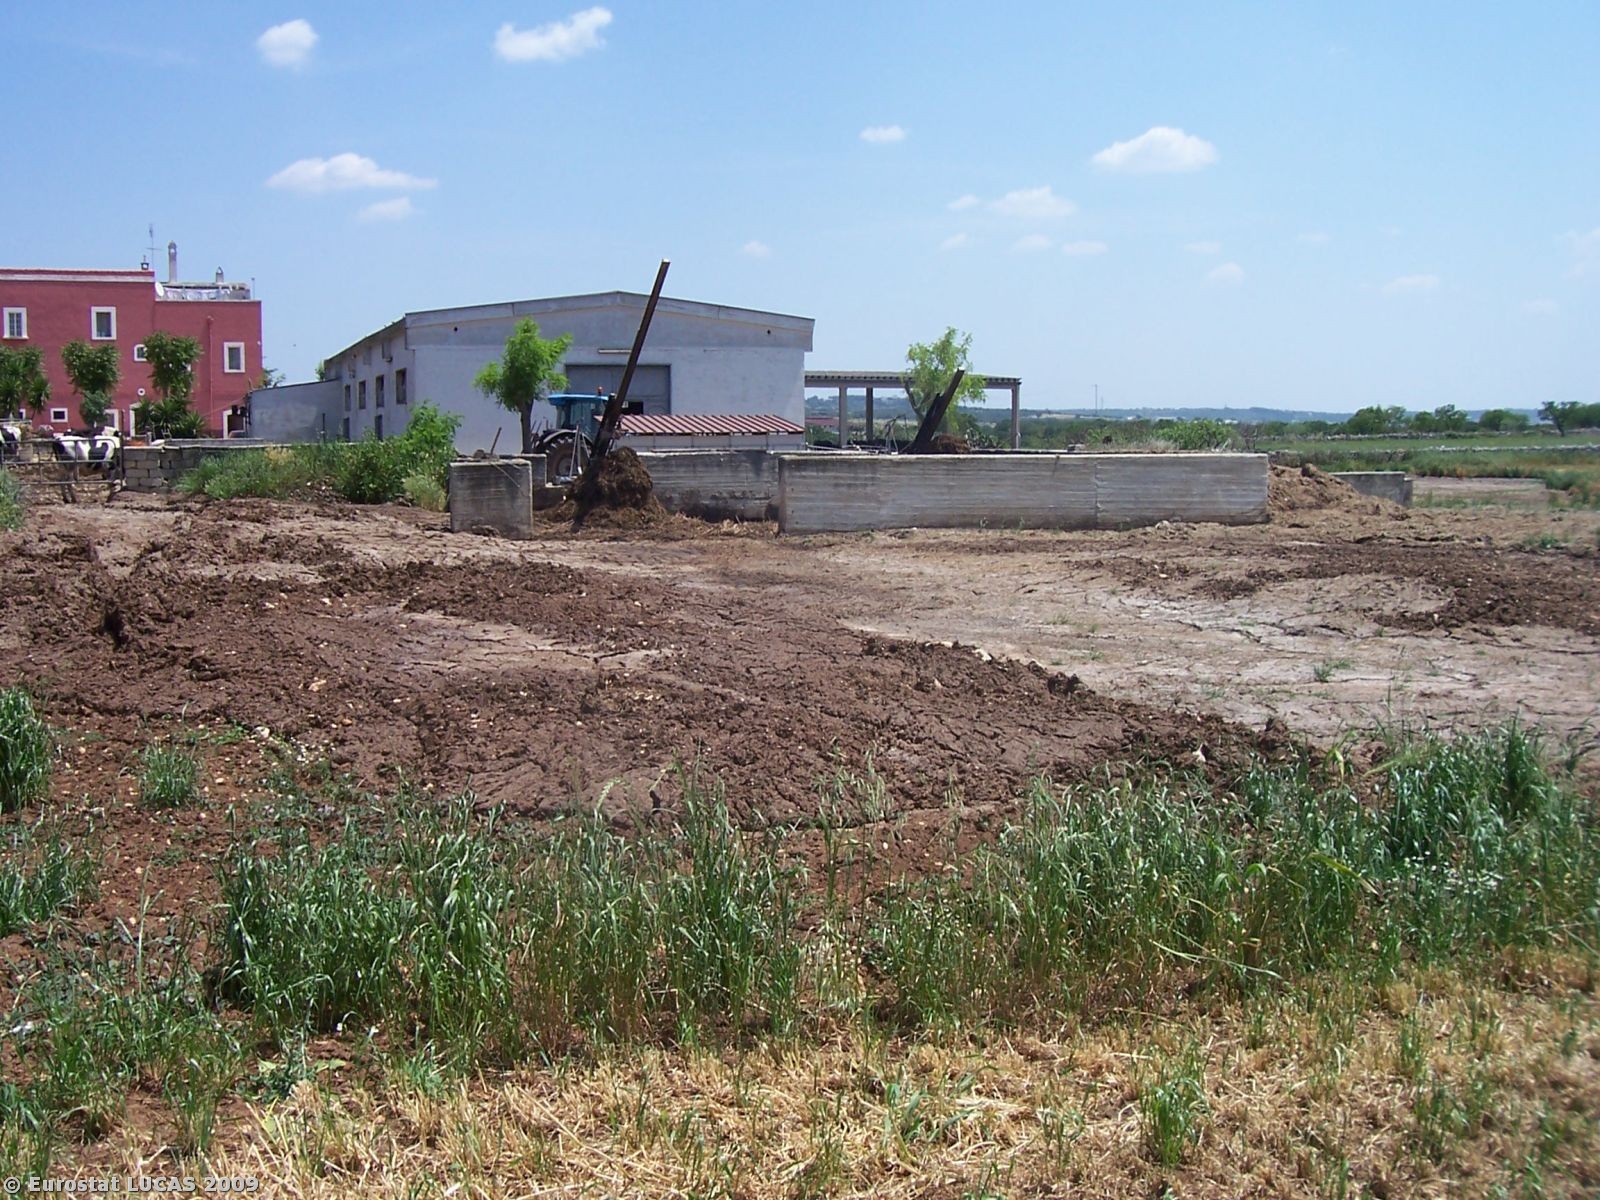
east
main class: Cropland
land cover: Other leguminous and mixtures for fodder
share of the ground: < 10 %
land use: Agriculture (excluding fallow land and kitchen gardens)
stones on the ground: < 10 %
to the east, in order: Other leguminous and mixtures for fodder; Artificial constructions in urban areas; Bare land; Fences; Other leguminous and mixtures for fodder; Fences; Bare land; Artificial constructions in urban areas; Bare land; Fences; Bare land; Fences; Mixed cereals for fodder; Dry stone walls; Mixed cereals for fodder
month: May
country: IT
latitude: 40.7449
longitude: 16.9764
